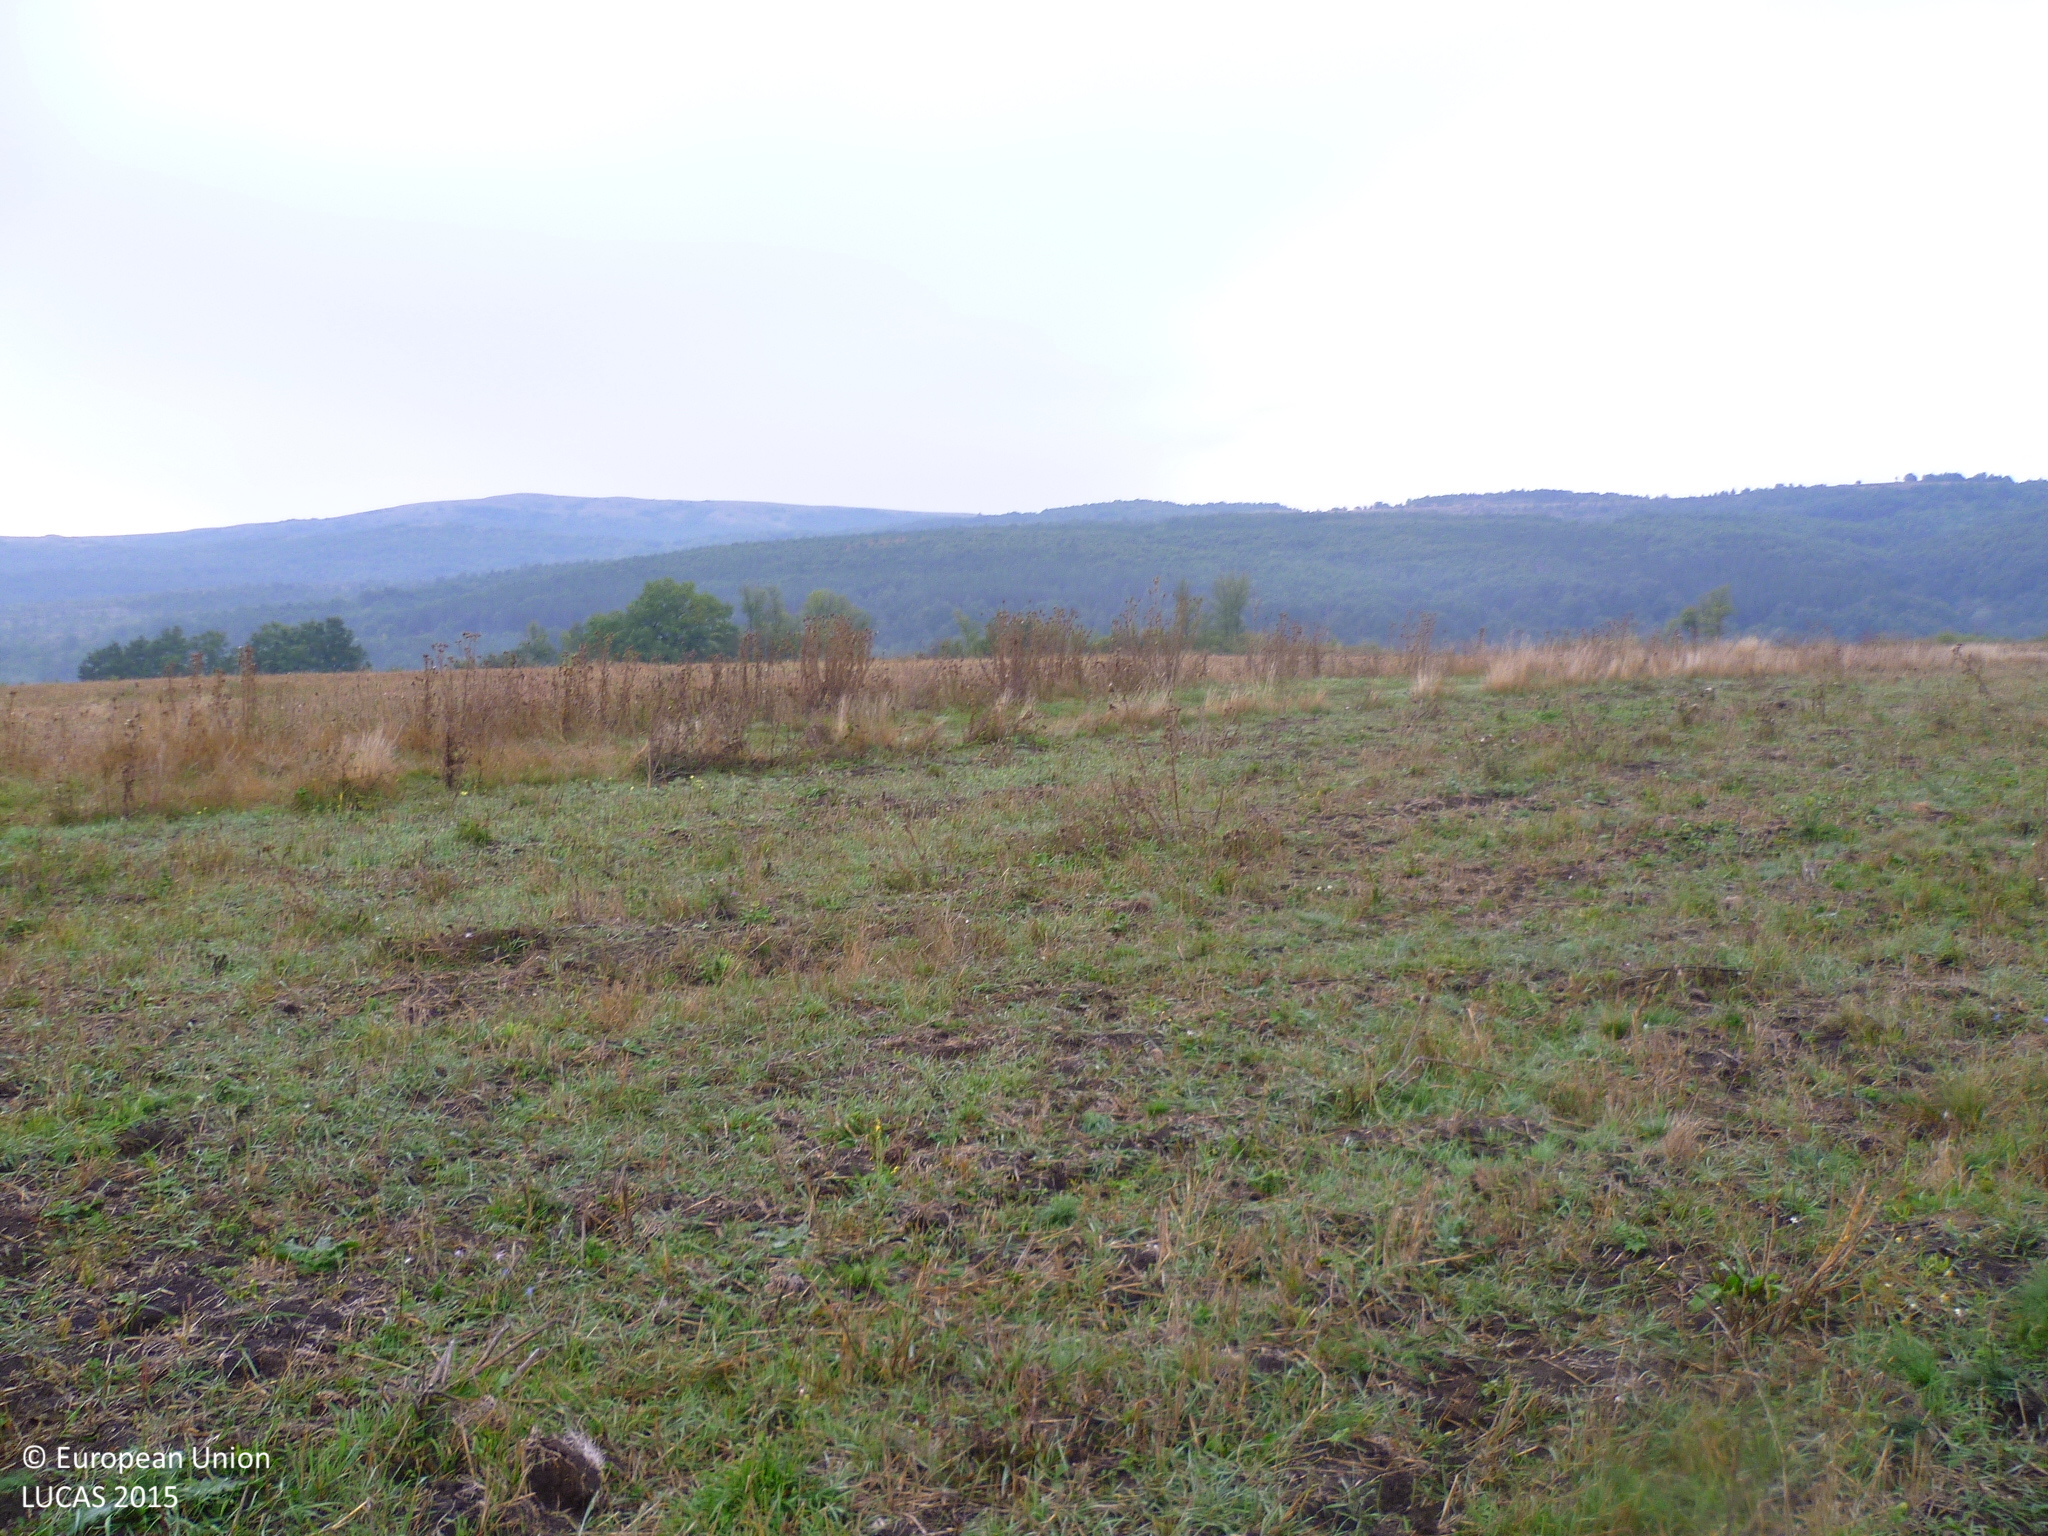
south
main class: Grassland
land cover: Grassland without tree/shrub cover
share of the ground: > 75 %
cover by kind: herbaceous plants 100 %
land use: Agriculture (excluding fallow land and kitchen gardens)
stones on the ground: < 10 %
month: October
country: BG
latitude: 42.9881
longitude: 22.9461
